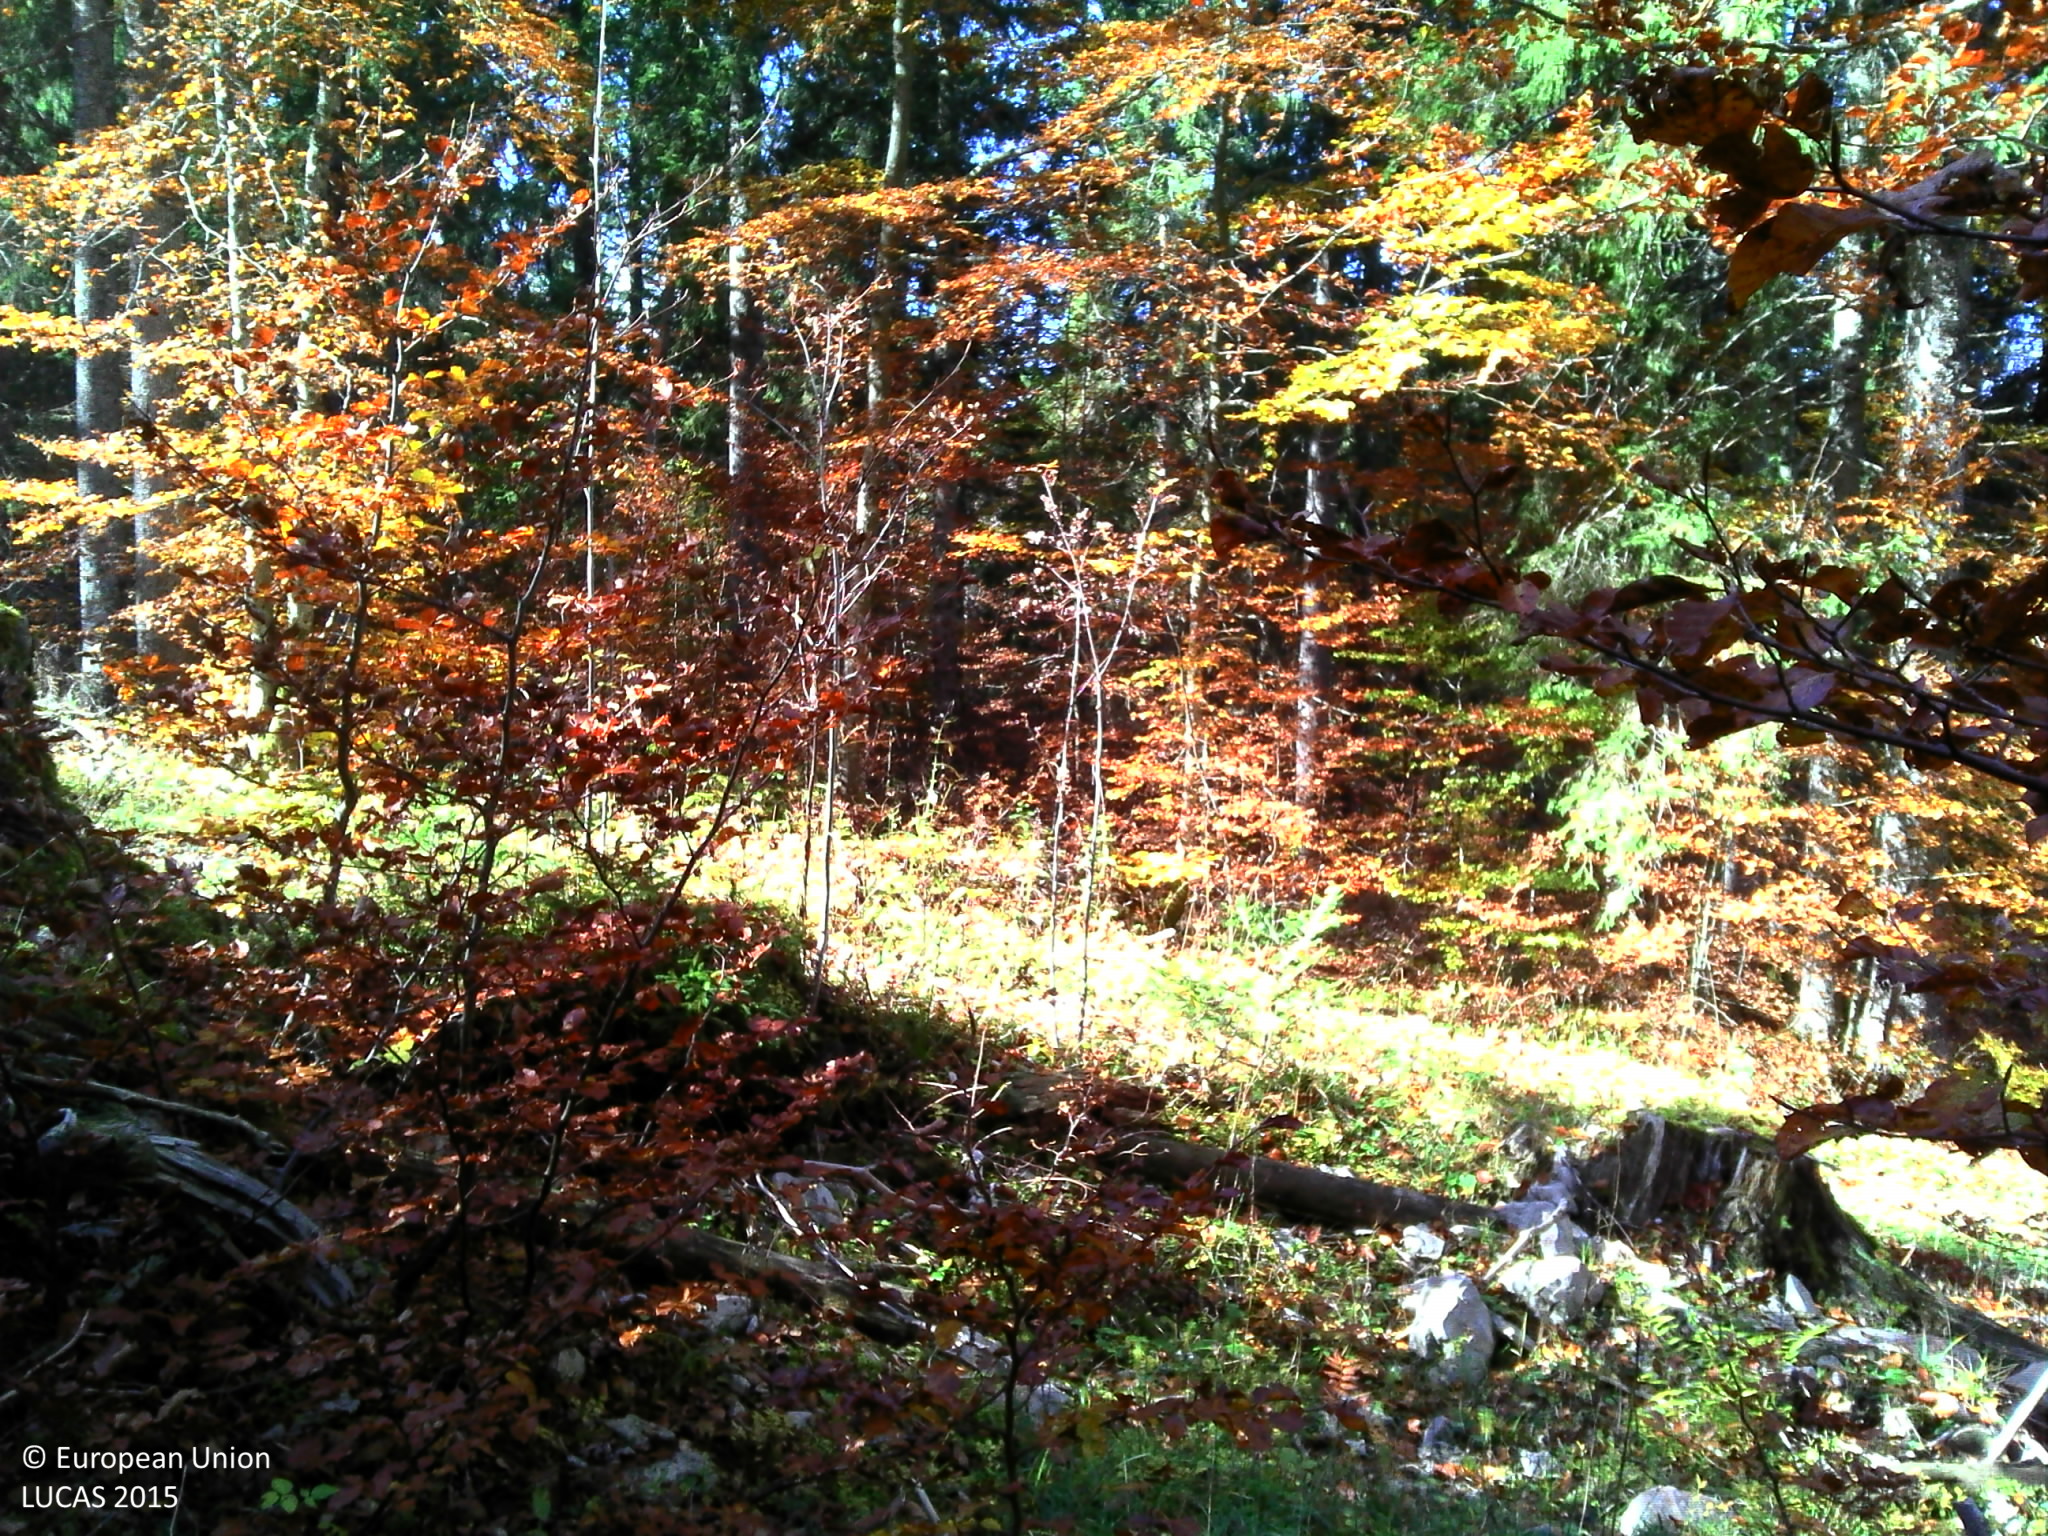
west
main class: Woodland
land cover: Spruce dominated mixed woodland
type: mountainous beech forest
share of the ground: > 75 %
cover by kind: broadleaved forest trees 40 %, coniferous forest trees 30 %, herbaceous plants 10 %, lichens and mosses 10 %, consolidated bare surface 5 %, unconsolidated bare surface 5 %
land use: Forestry
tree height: > 5 m
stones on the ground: 10 - 25 %
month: October
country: FR
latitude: 46.6245
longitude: 6.1501
